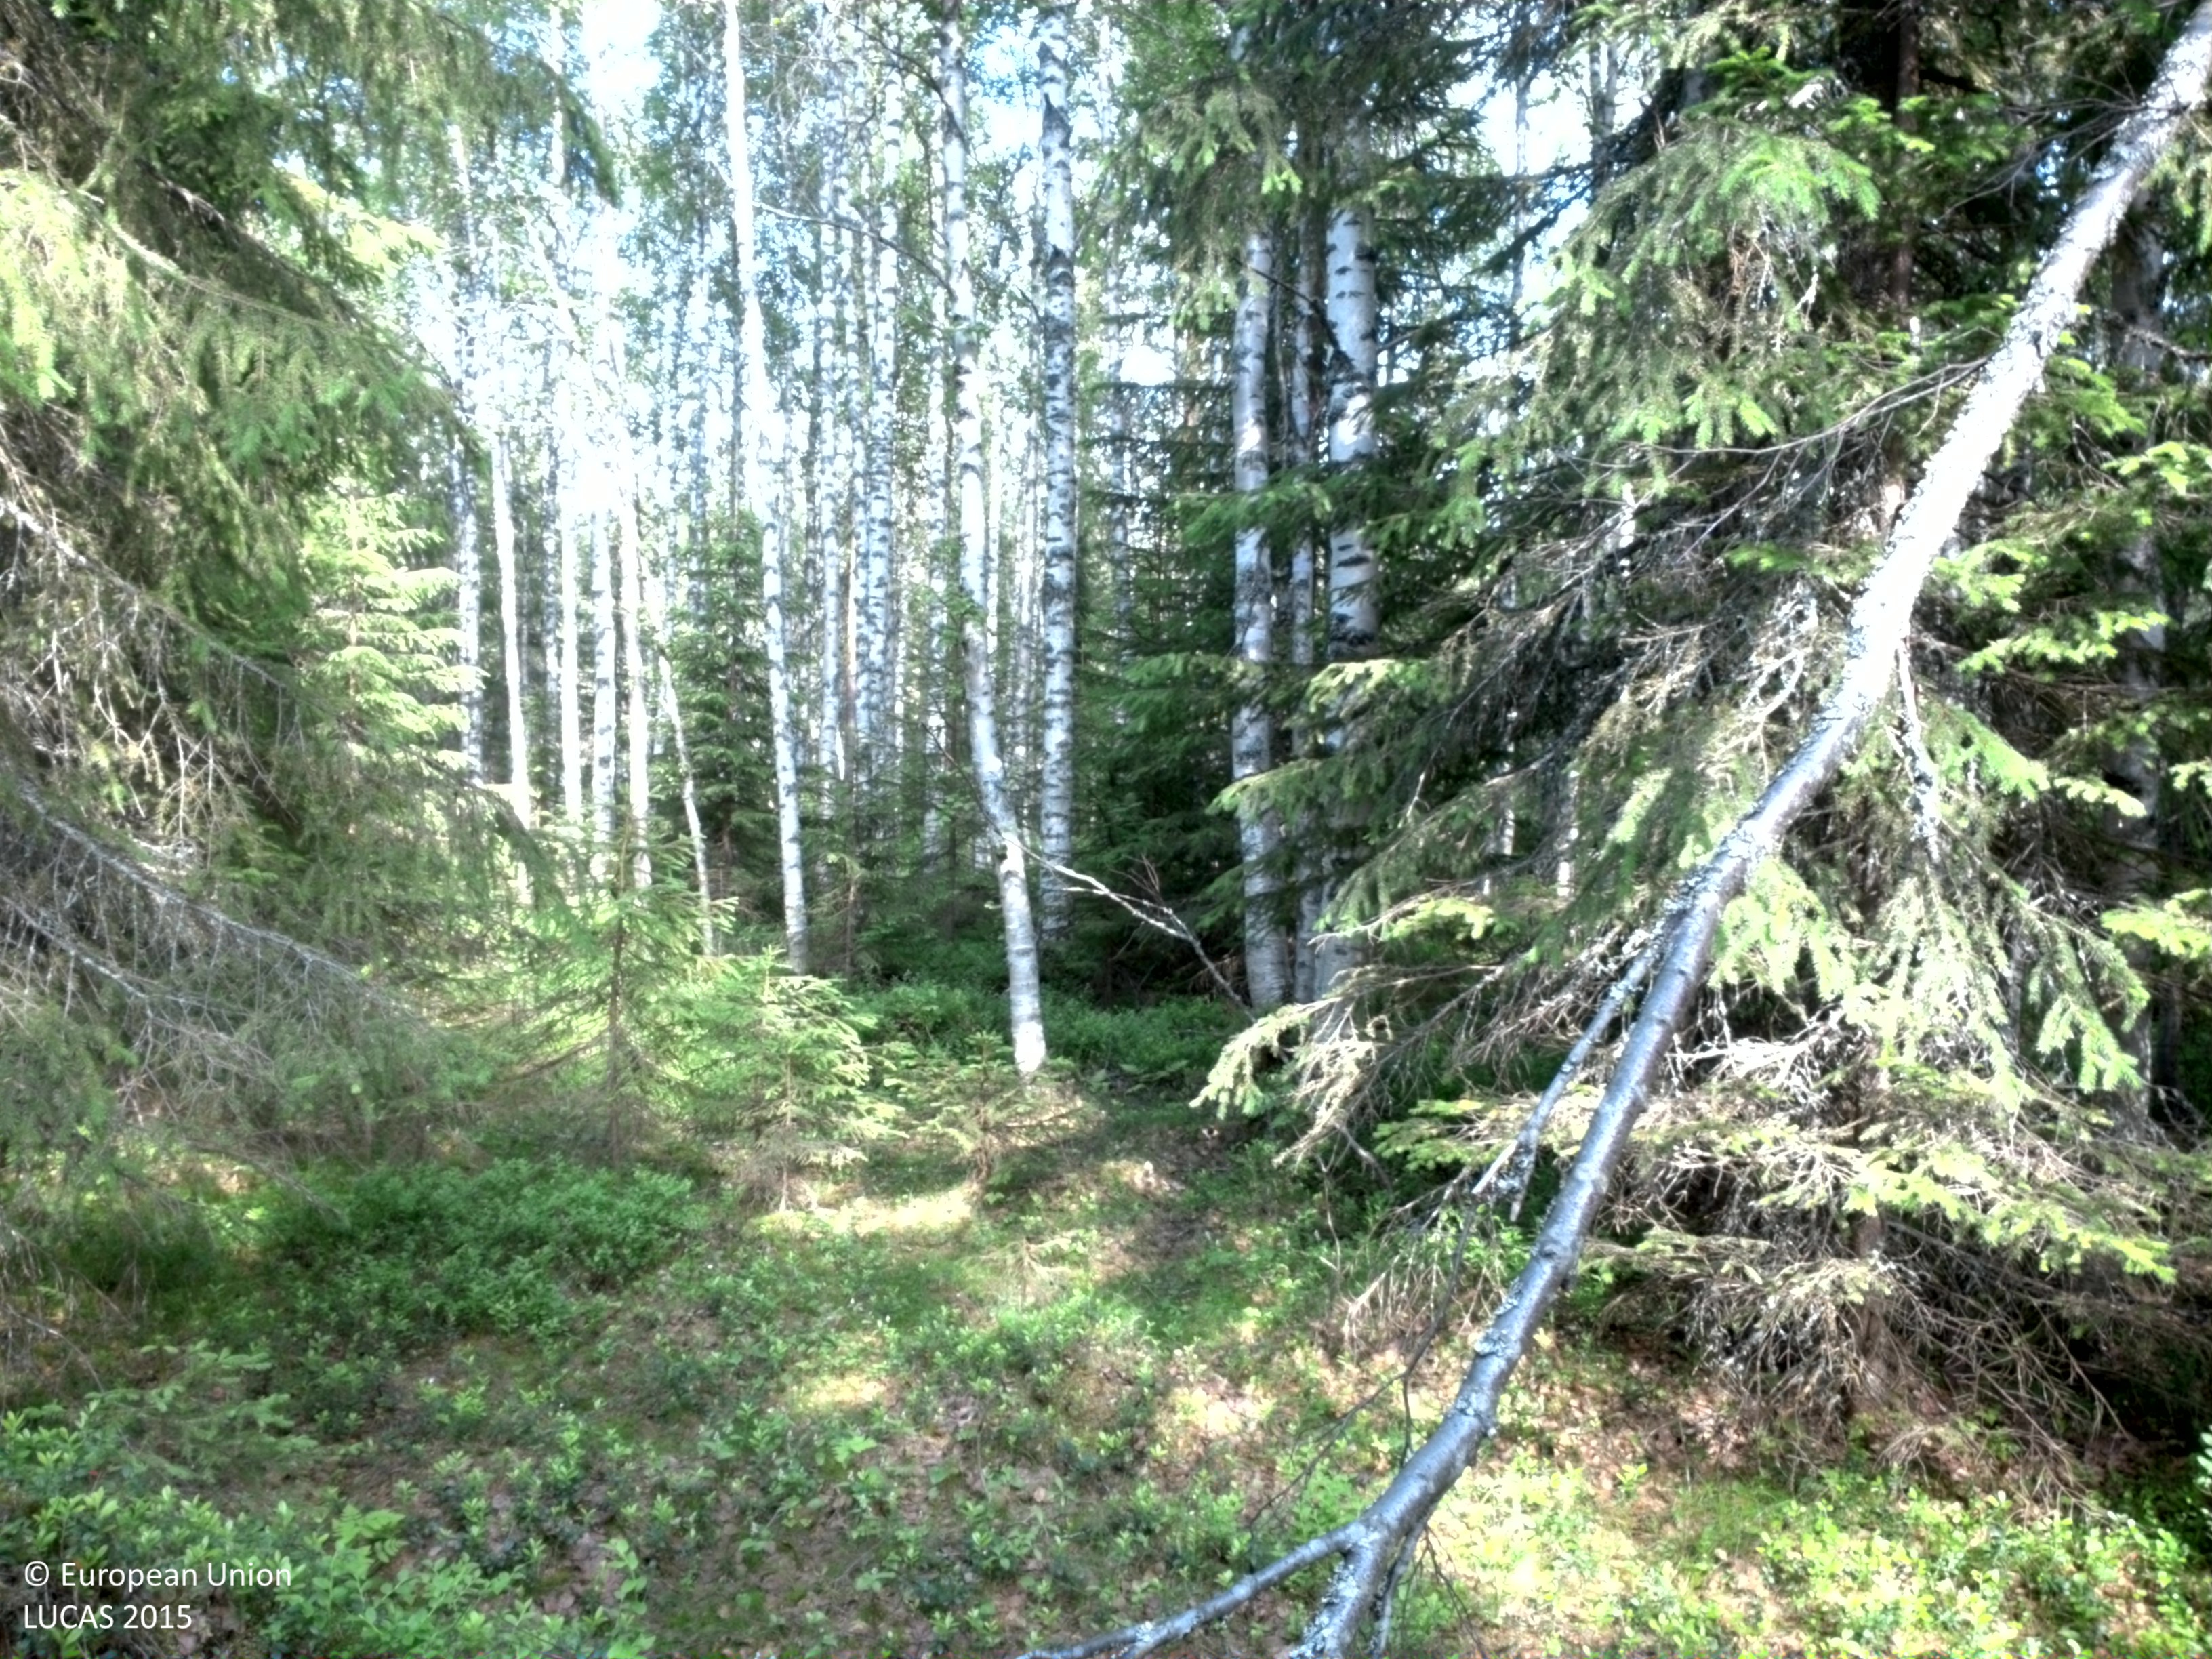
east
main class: Woodland
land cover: Other mixed woodland
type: boreal forest
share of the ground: 50 - 75 %
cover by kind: coniferous forest trees 45 %, shrubs 35 %, broadleaved forest trees 15 %, herbaceous plants 5 %
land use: Forestry
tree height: > 5 m
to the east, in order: Other mixed woodland; Spruce dominated coniferous woodland; Pine dominated coniferous woodland; Other coniferous woodland; Pine dominated coniferous woodland; Other coniferous woodland; Ditches and canals; Other coniferous woodland
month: July
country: SE
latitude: 64.4456
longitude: 20.8467
